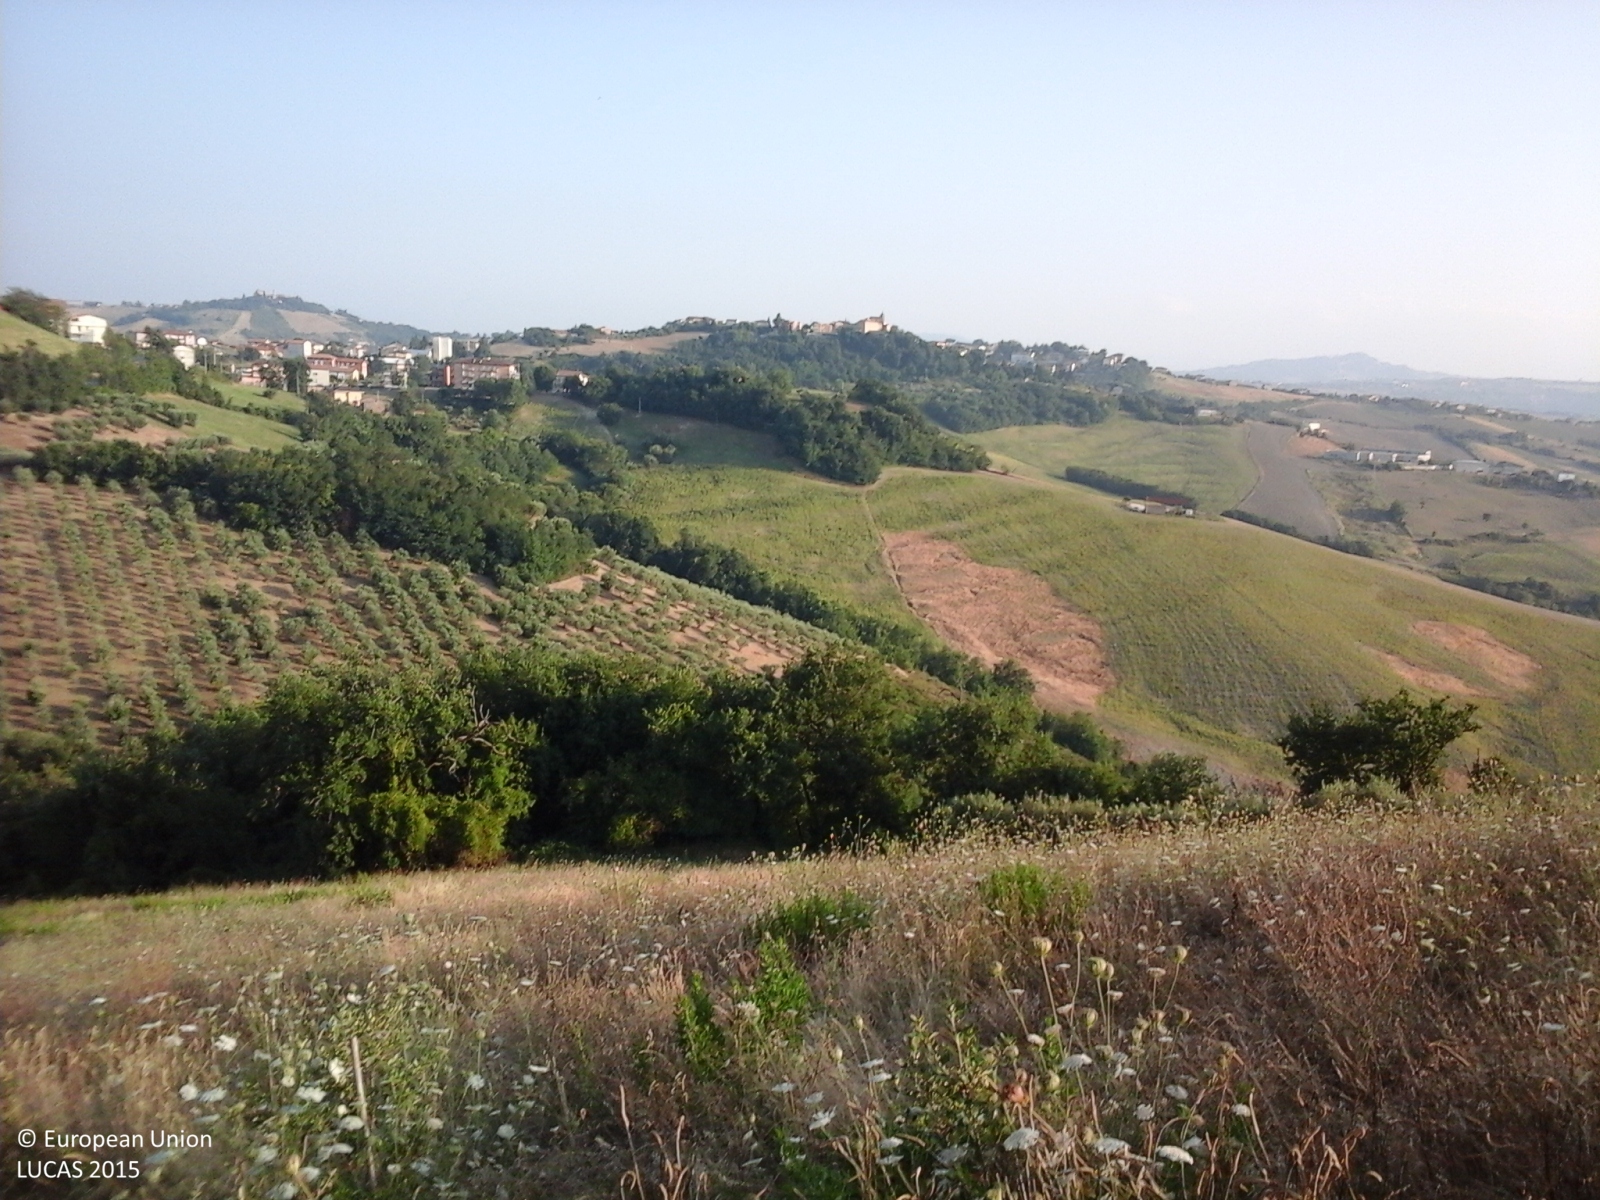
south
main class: Grassland
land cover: Spontaneously vegetated surfaces
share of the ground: > 75 %
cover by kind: herbaceous plants 100 %
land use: Fallow land
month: August
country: IT
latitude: 43.1548
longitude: 13.4710
